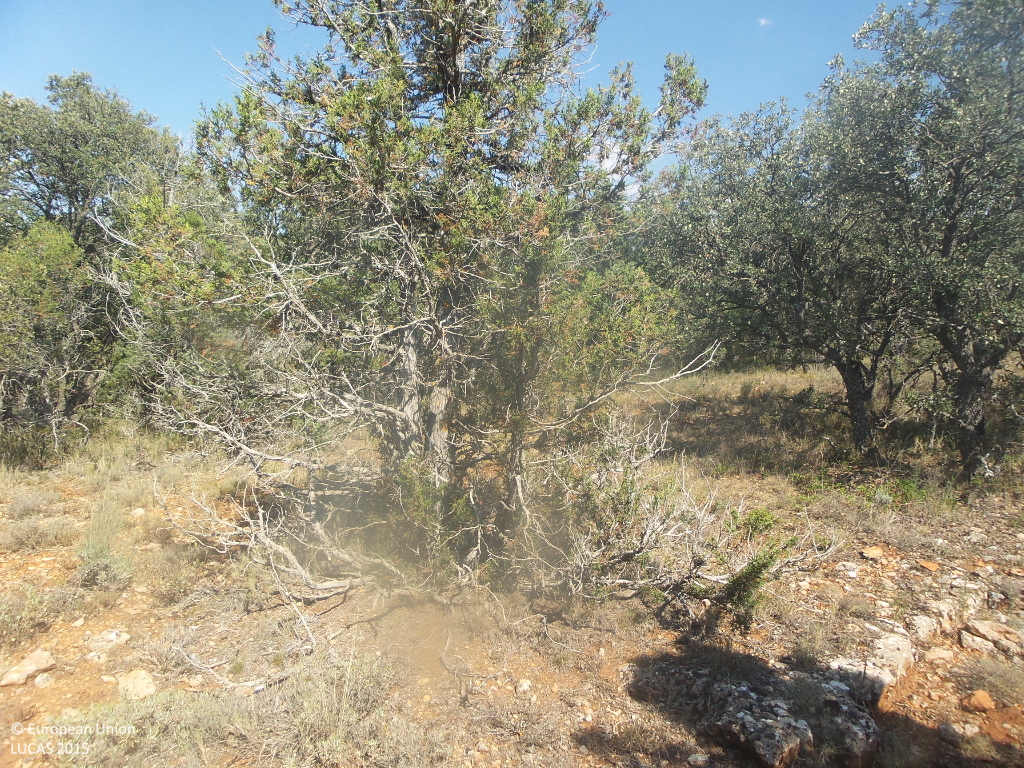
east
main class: Woodland
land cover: Other mixed woodland
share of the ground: 50 - 75 %
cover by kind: coniferous forest trees 40 %, broadleaved forest trees 20 %, shrubs 20 %, herbaceous plants 10 %, unconsolidated bare surface 10 %
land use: Semi-natural and natural areas not in use
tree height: < 5 m
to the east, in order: Other mixed woodland; Paved roads, cycling and walking lanes; Other mixed woodland; Barley
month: July
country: ES
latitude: 41.1594
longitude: -2.0998
